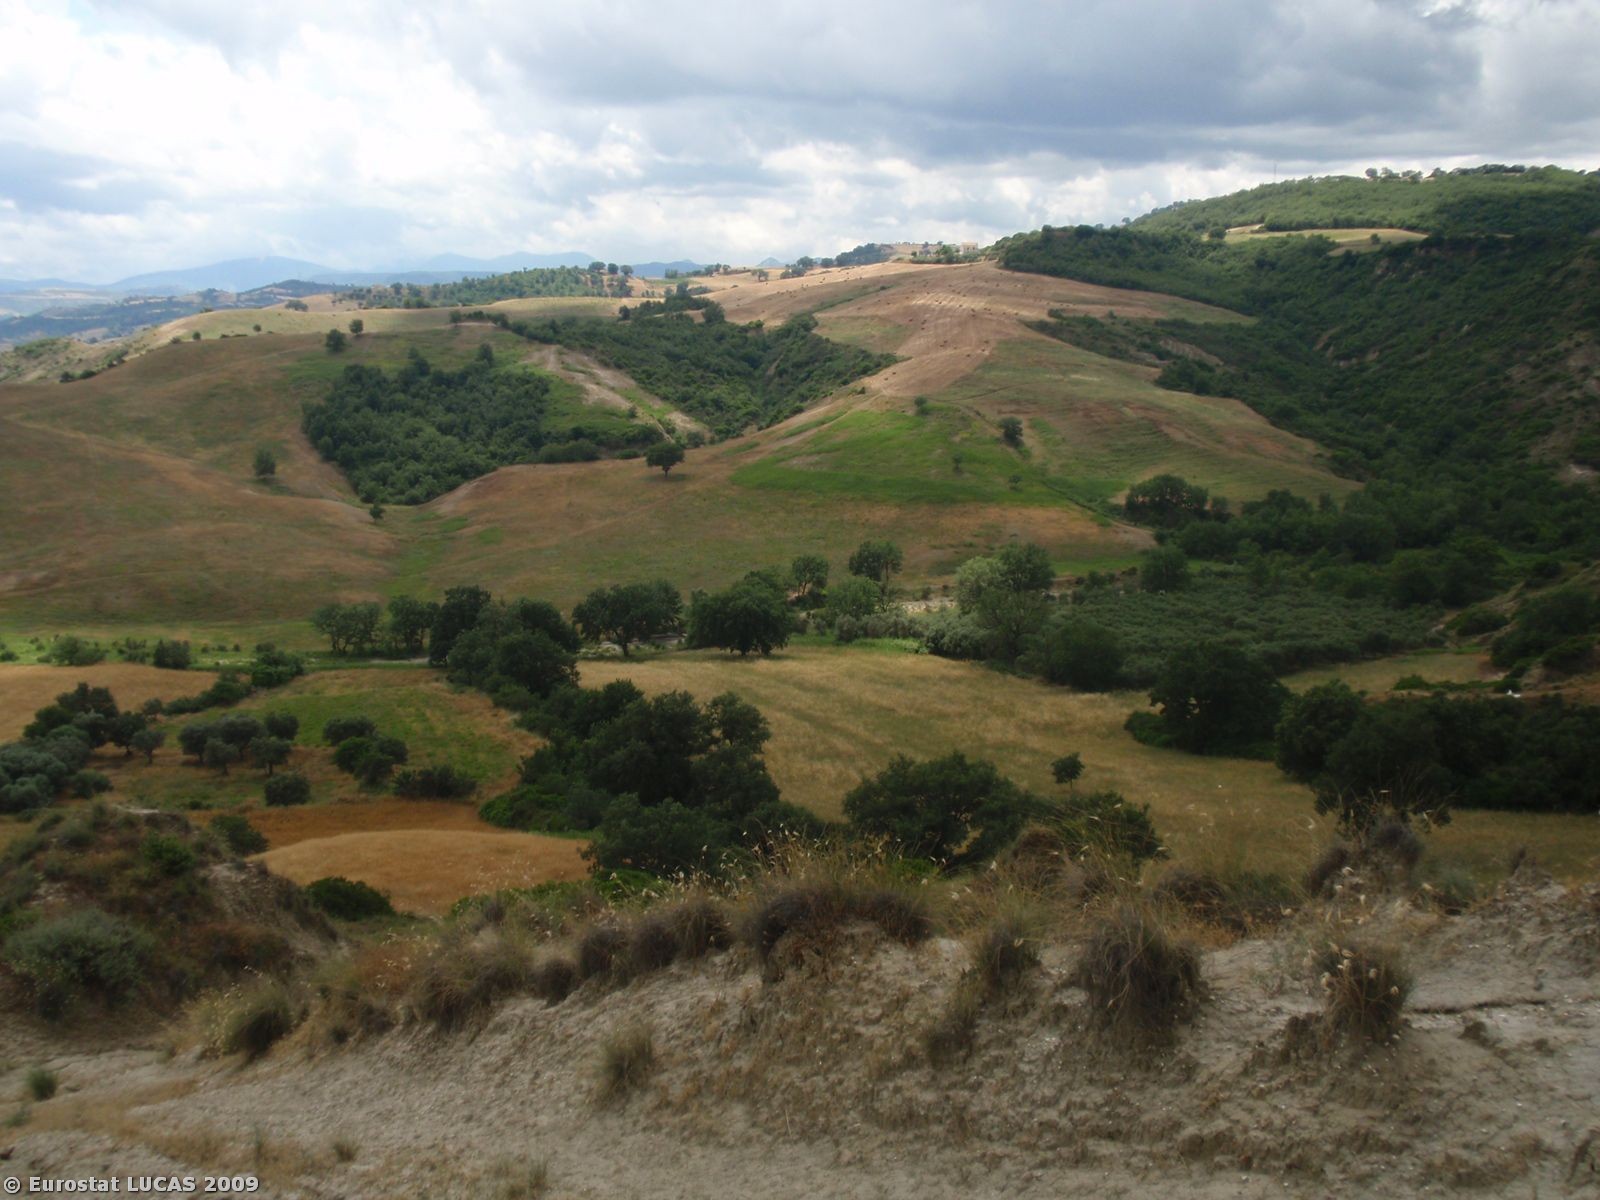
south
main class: Shrubland
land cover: Shrubland with sparse tree cover
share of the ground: > 75 %
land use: Agriculture (excluding fallow land and kitchen gardens)
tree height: < 5 m
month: June
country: IT
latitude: 40.2124
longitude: 16.2608
